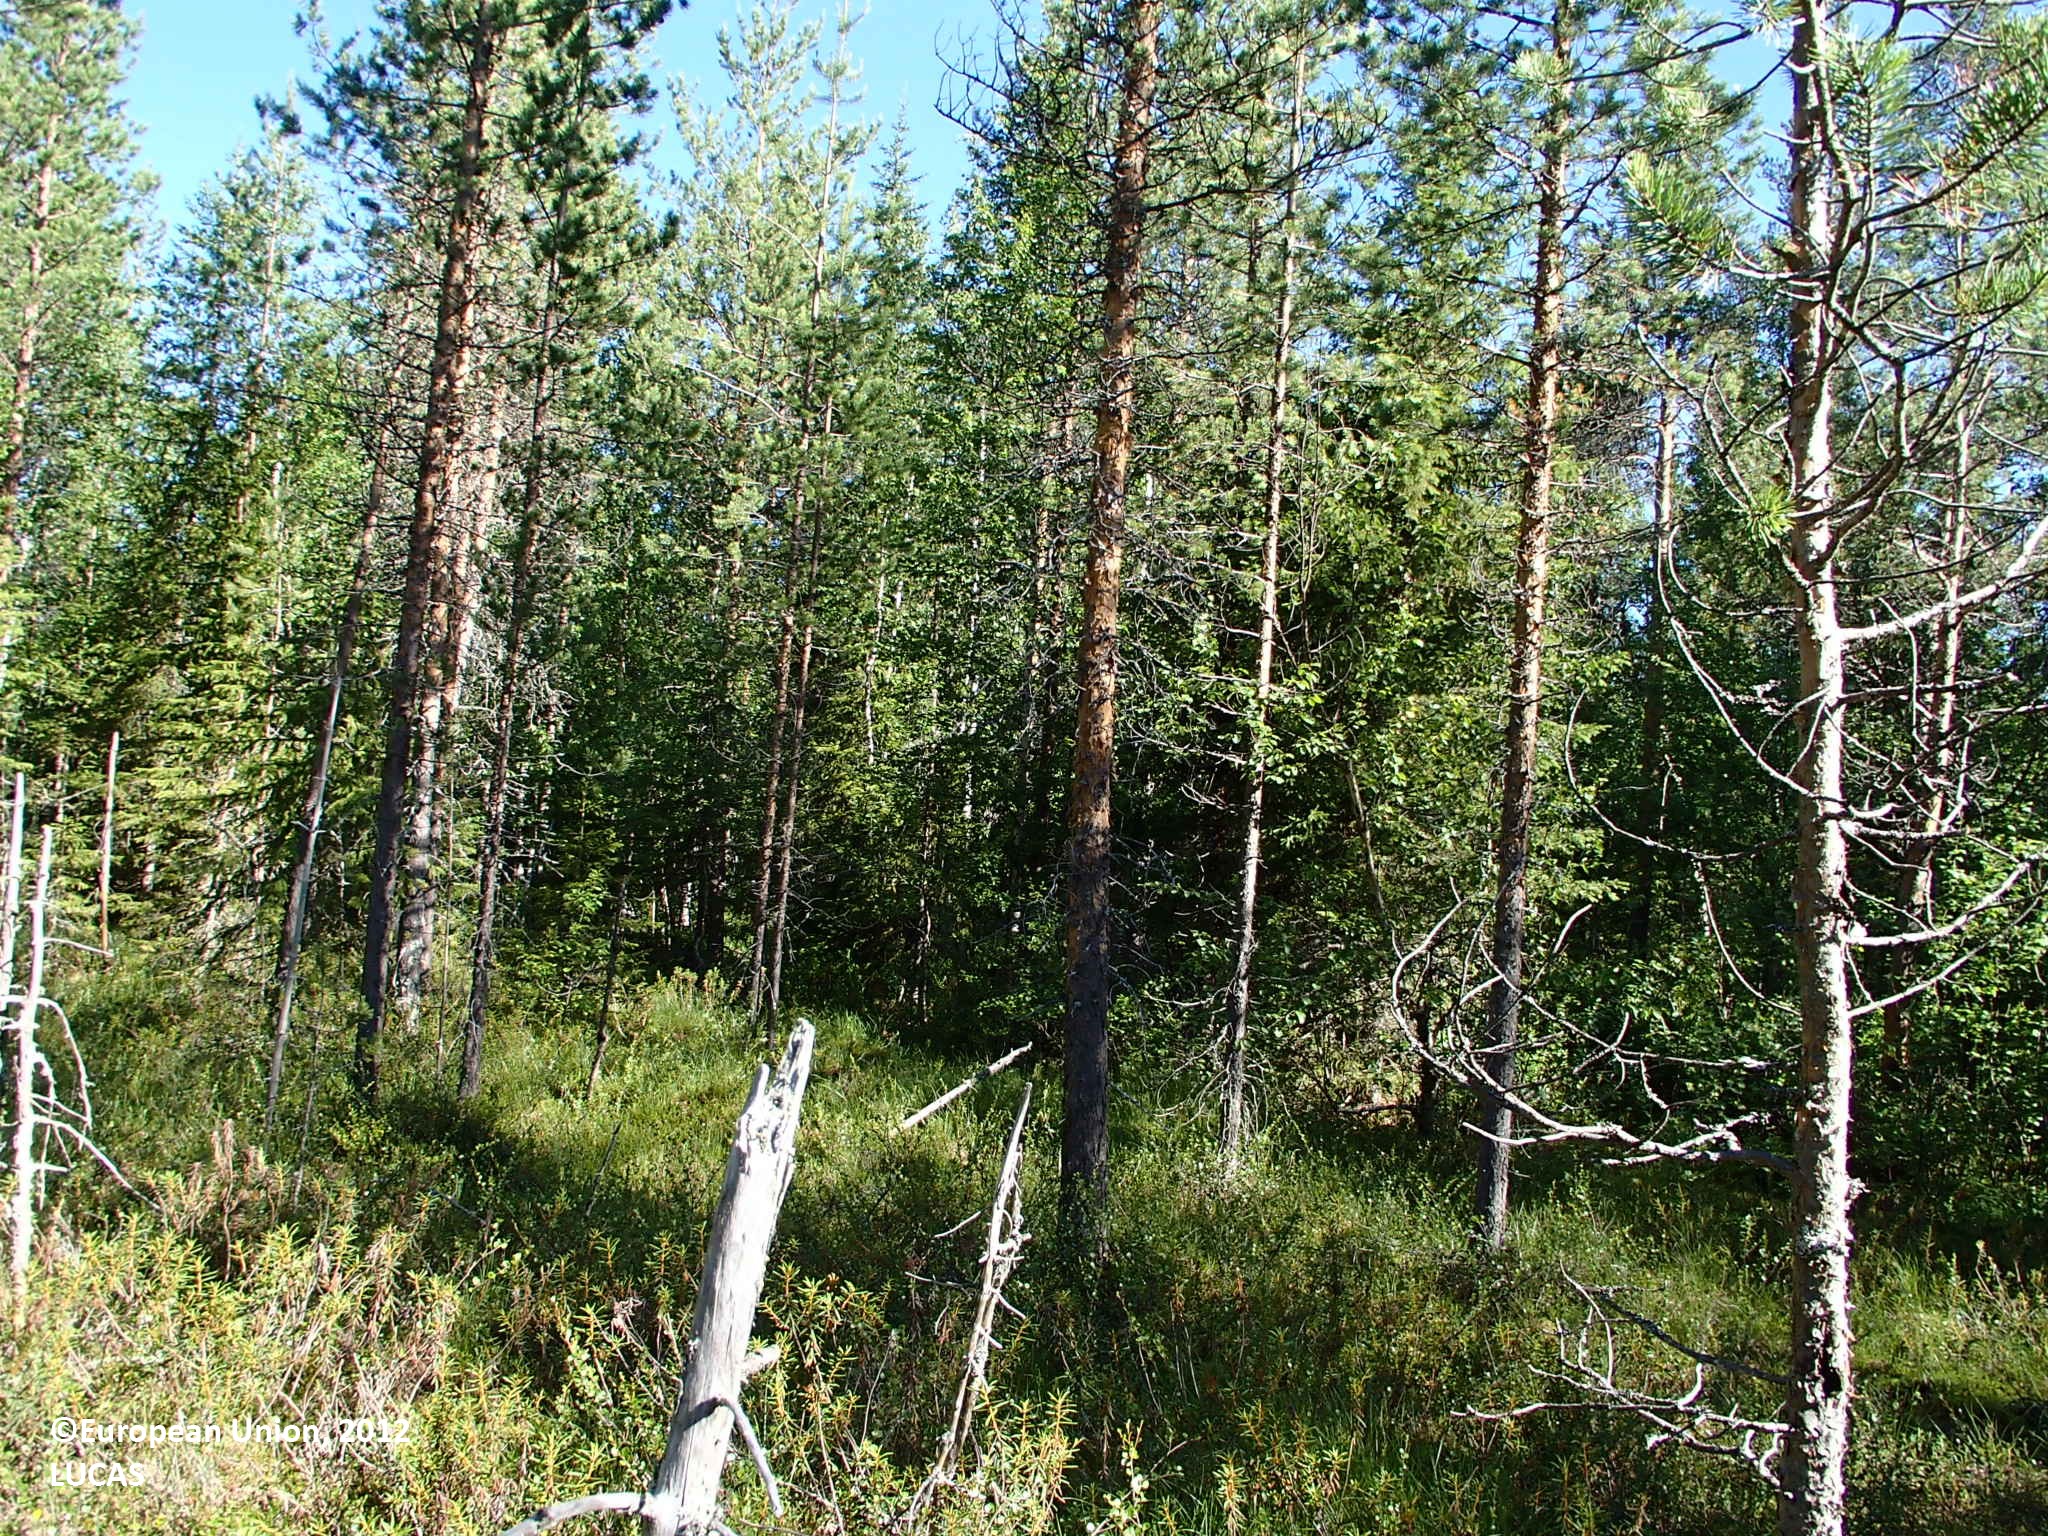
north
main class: Woodland
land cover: Pine dominated coniferous woodland
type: boreal forest
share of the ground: 25 - 50 %
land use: Forestry
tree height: > 5 m
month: July
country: FI
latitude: 66.8292
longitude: 25.3378
